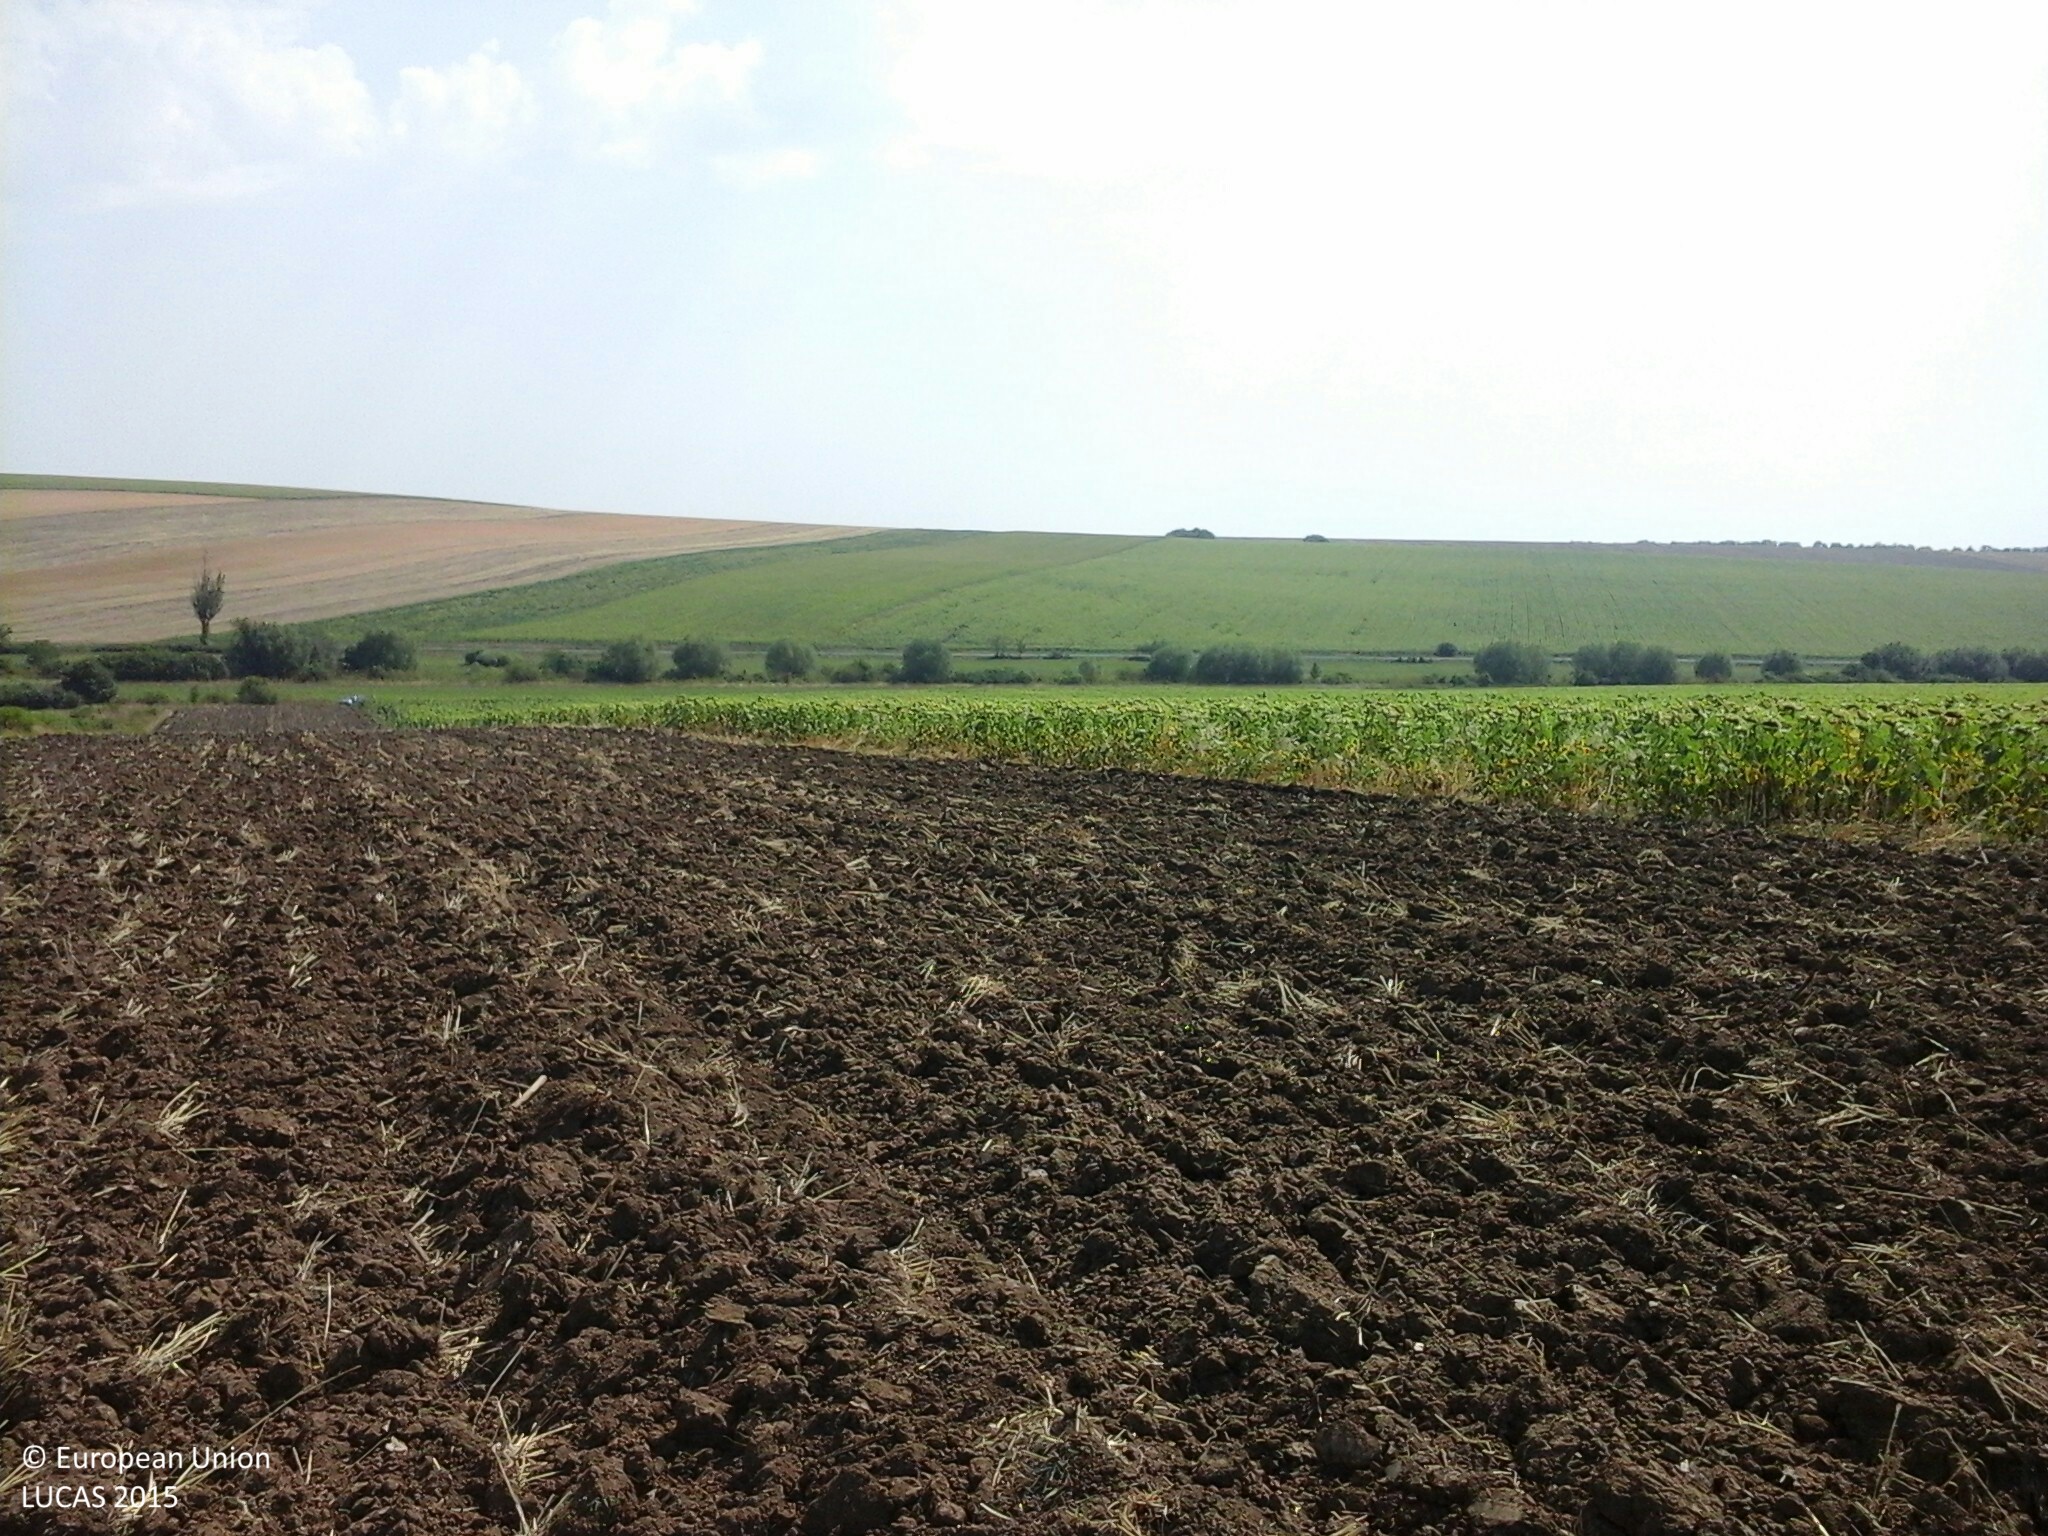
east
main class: Cropland
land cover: Common wheat
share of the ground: < 10 %
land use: Agriculture (excluding fallow land and kitchen gardens)
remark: Harvested field
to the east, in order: Common wheat; Sunflower
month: August
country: HU
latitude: 47.9368
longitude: 20.7040
